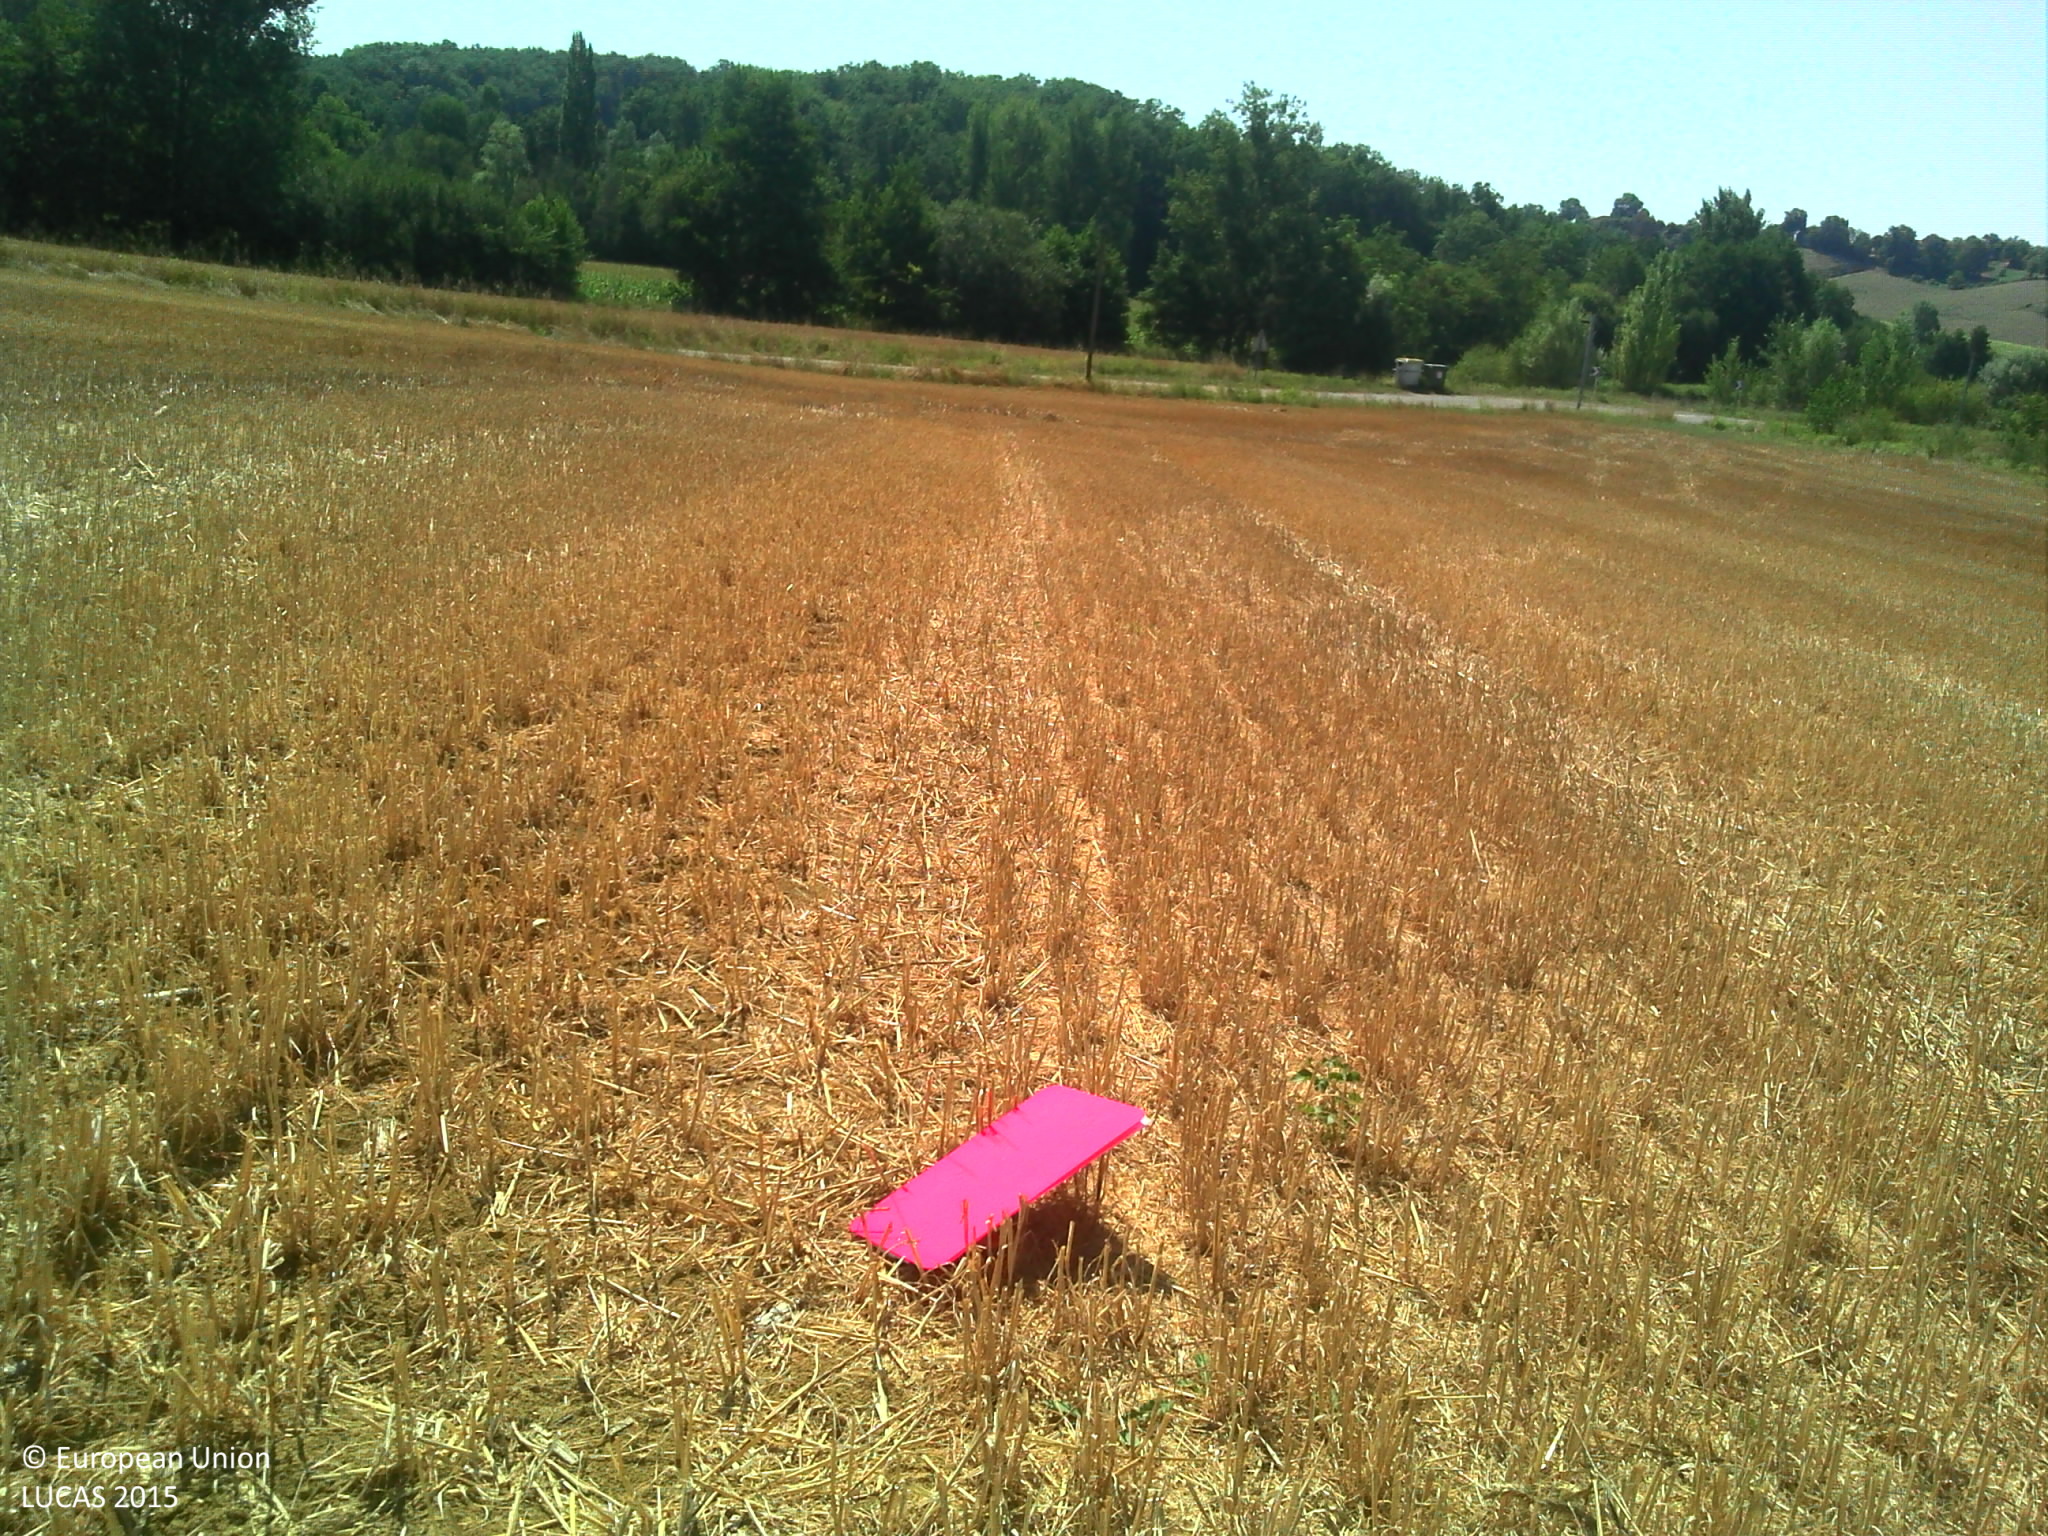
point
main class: Cropland
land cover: Common wheat
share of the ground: > 75 %
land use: Agriculture (excluding fallow land and kitchen gardens)
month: August
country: FR
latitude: 44.1960
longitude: 1.2273
